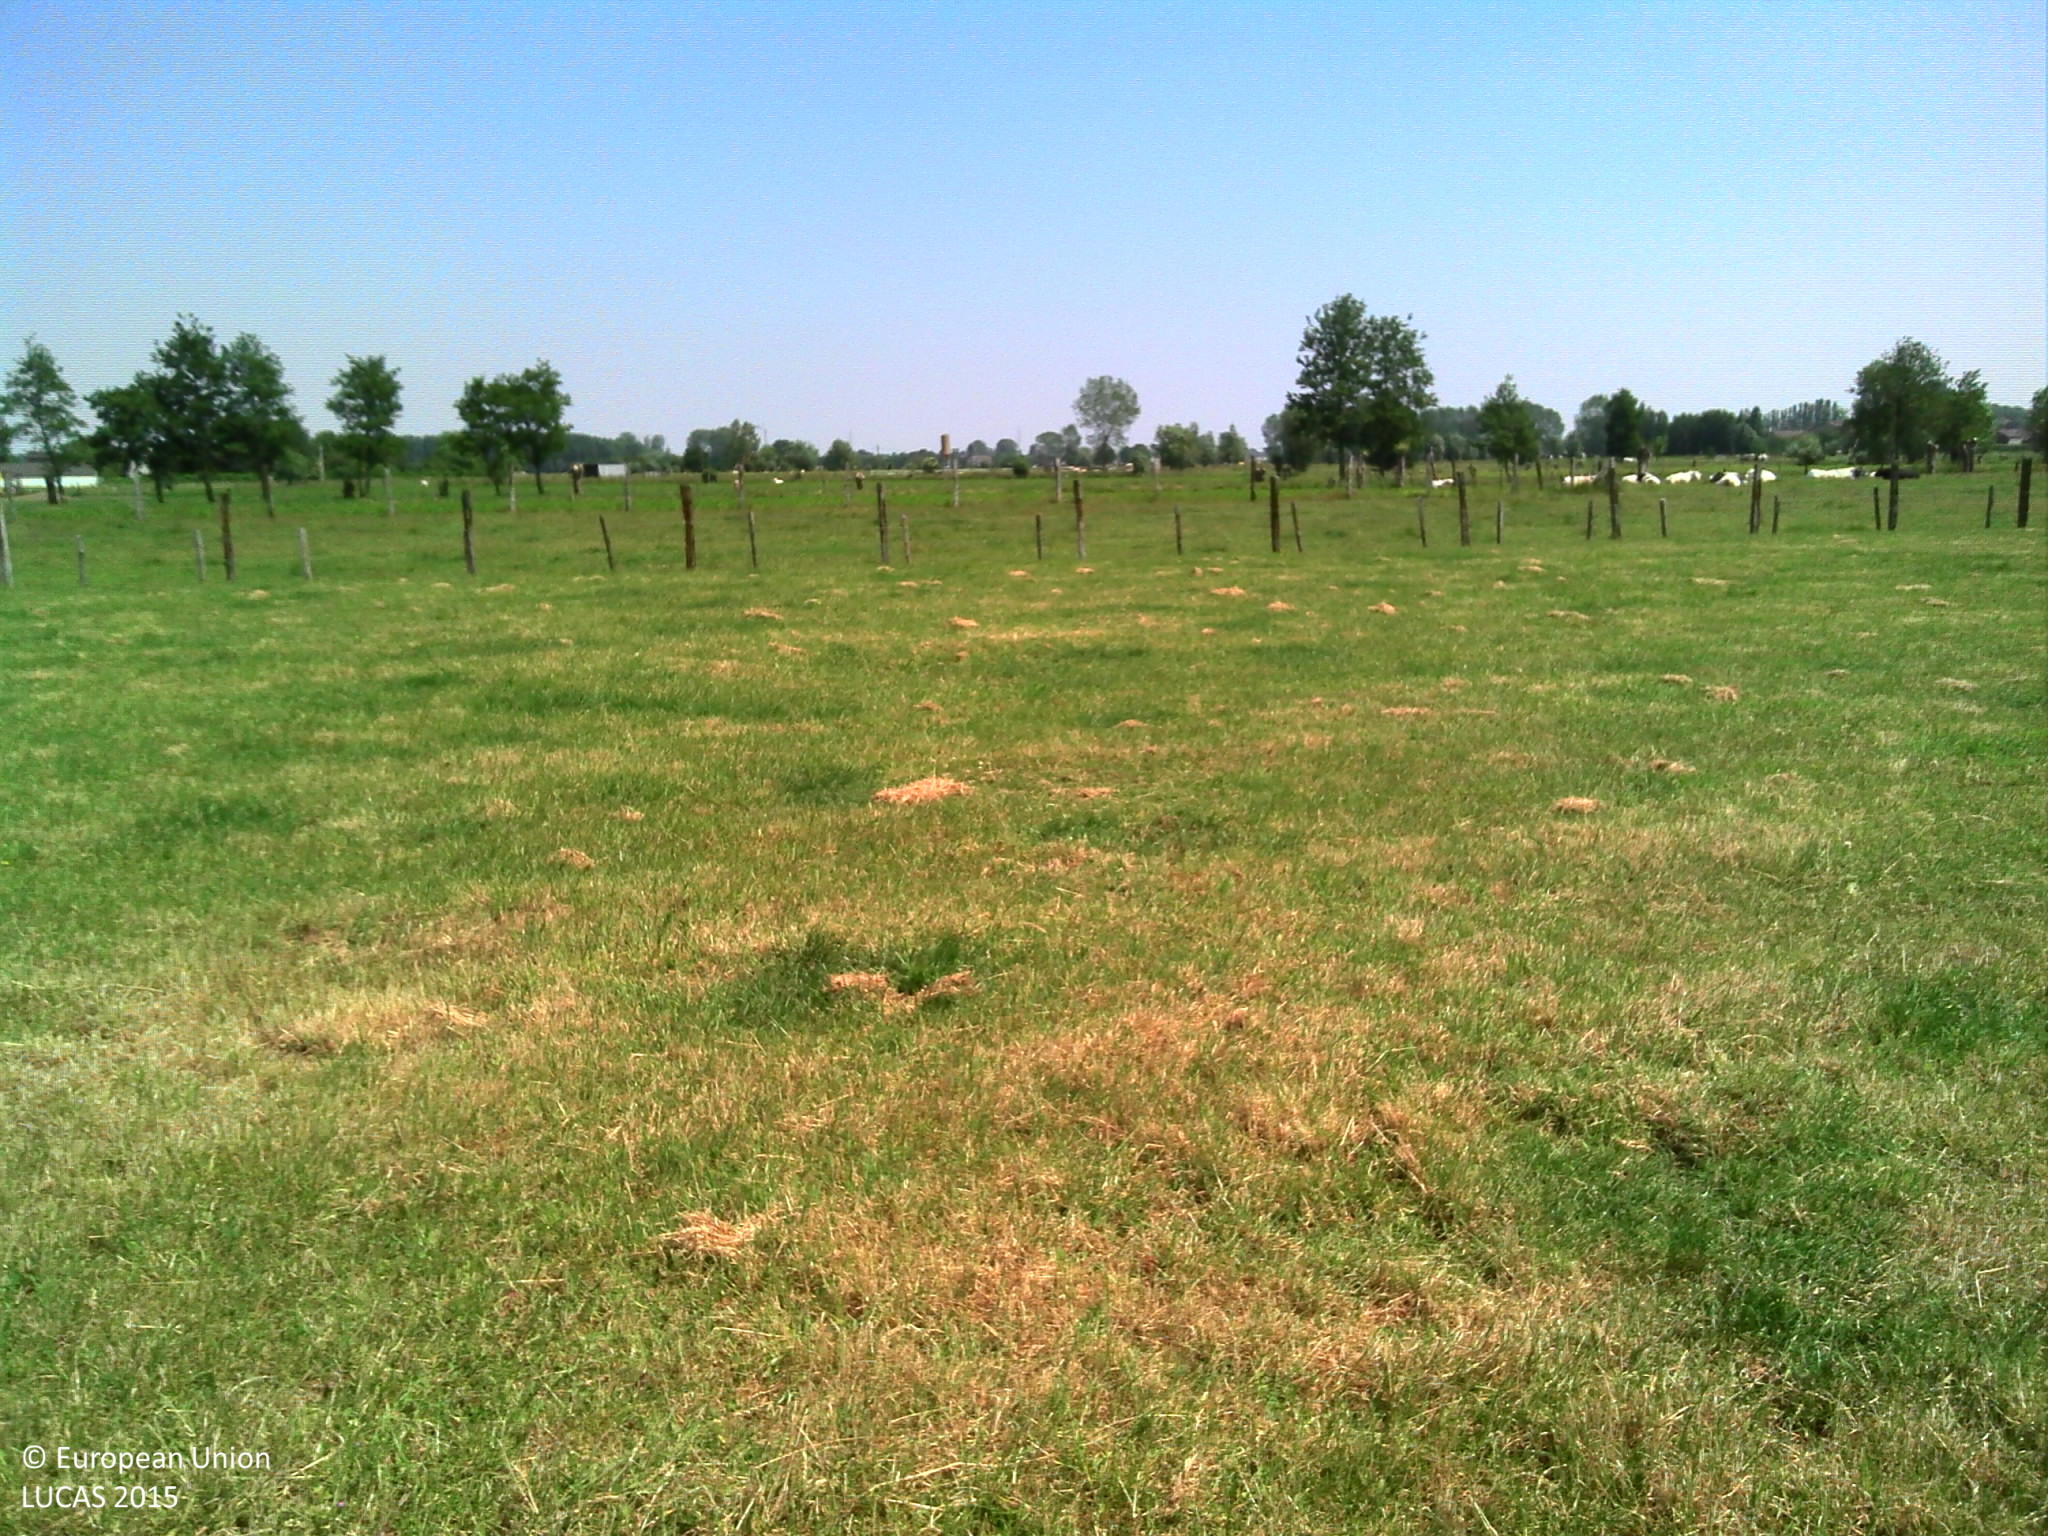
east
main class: Grassland
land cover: Grassland without tree/shrub cover
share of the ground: > 75 %
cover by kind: herbaceous plants 100 %
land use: Agriculture (excluding fallow land and kitchen gardens)
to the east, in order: Grassland without tree/shrub cover; Fences; Grass margins; Fences; Grass margins; Maize; Grass margins; Fences; Grassland without tree/shrub cover; Ditches and canals; Fences; Grassland without tree/shrub cover; Fences; Grass margins; Maize
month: June
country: BE
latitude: 51.0921
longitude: 4.0403
